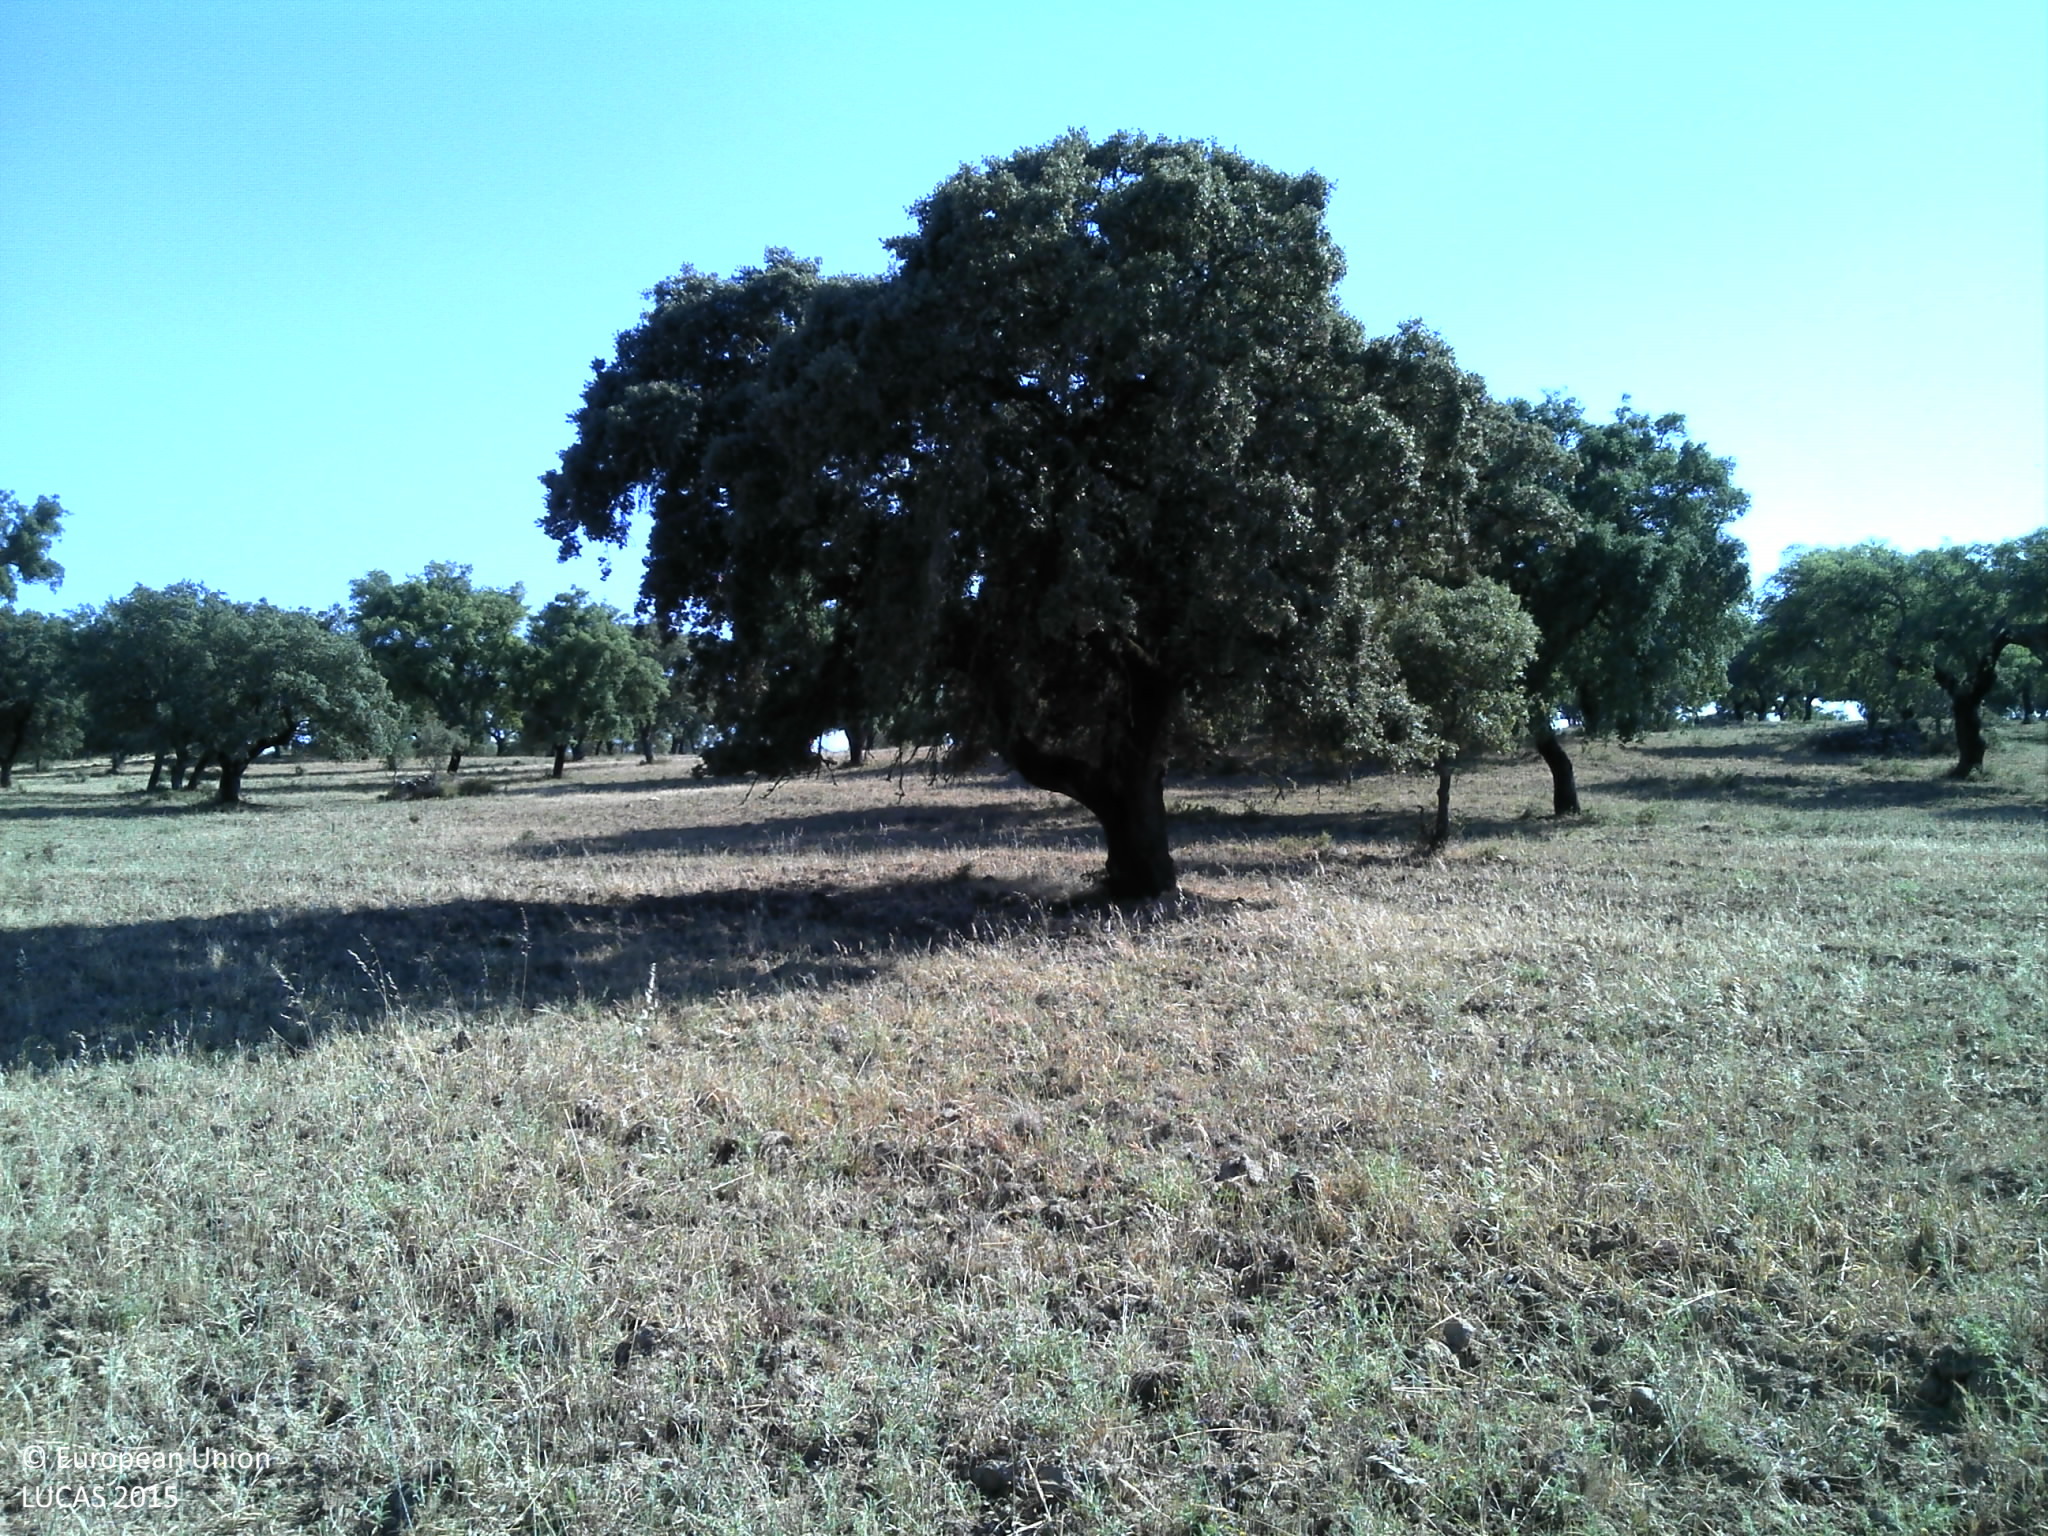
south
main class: Woodland
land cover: Broadleaved woodland
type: broadleaved evergreen forest
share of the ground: 10 - 25 %
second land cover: Grassland without tree/shrub cover
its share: 25 - 50 %
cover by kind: unconsolidated bare surface 55 %, herbaceous plants 25 %, broadleaved forest trees 20 %
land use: Forestry
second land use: Agriculture (excluding fallow land and kitchen gardens)
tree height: > 5 m
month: June
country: PT
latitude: 38.7088
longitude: -8.1368
